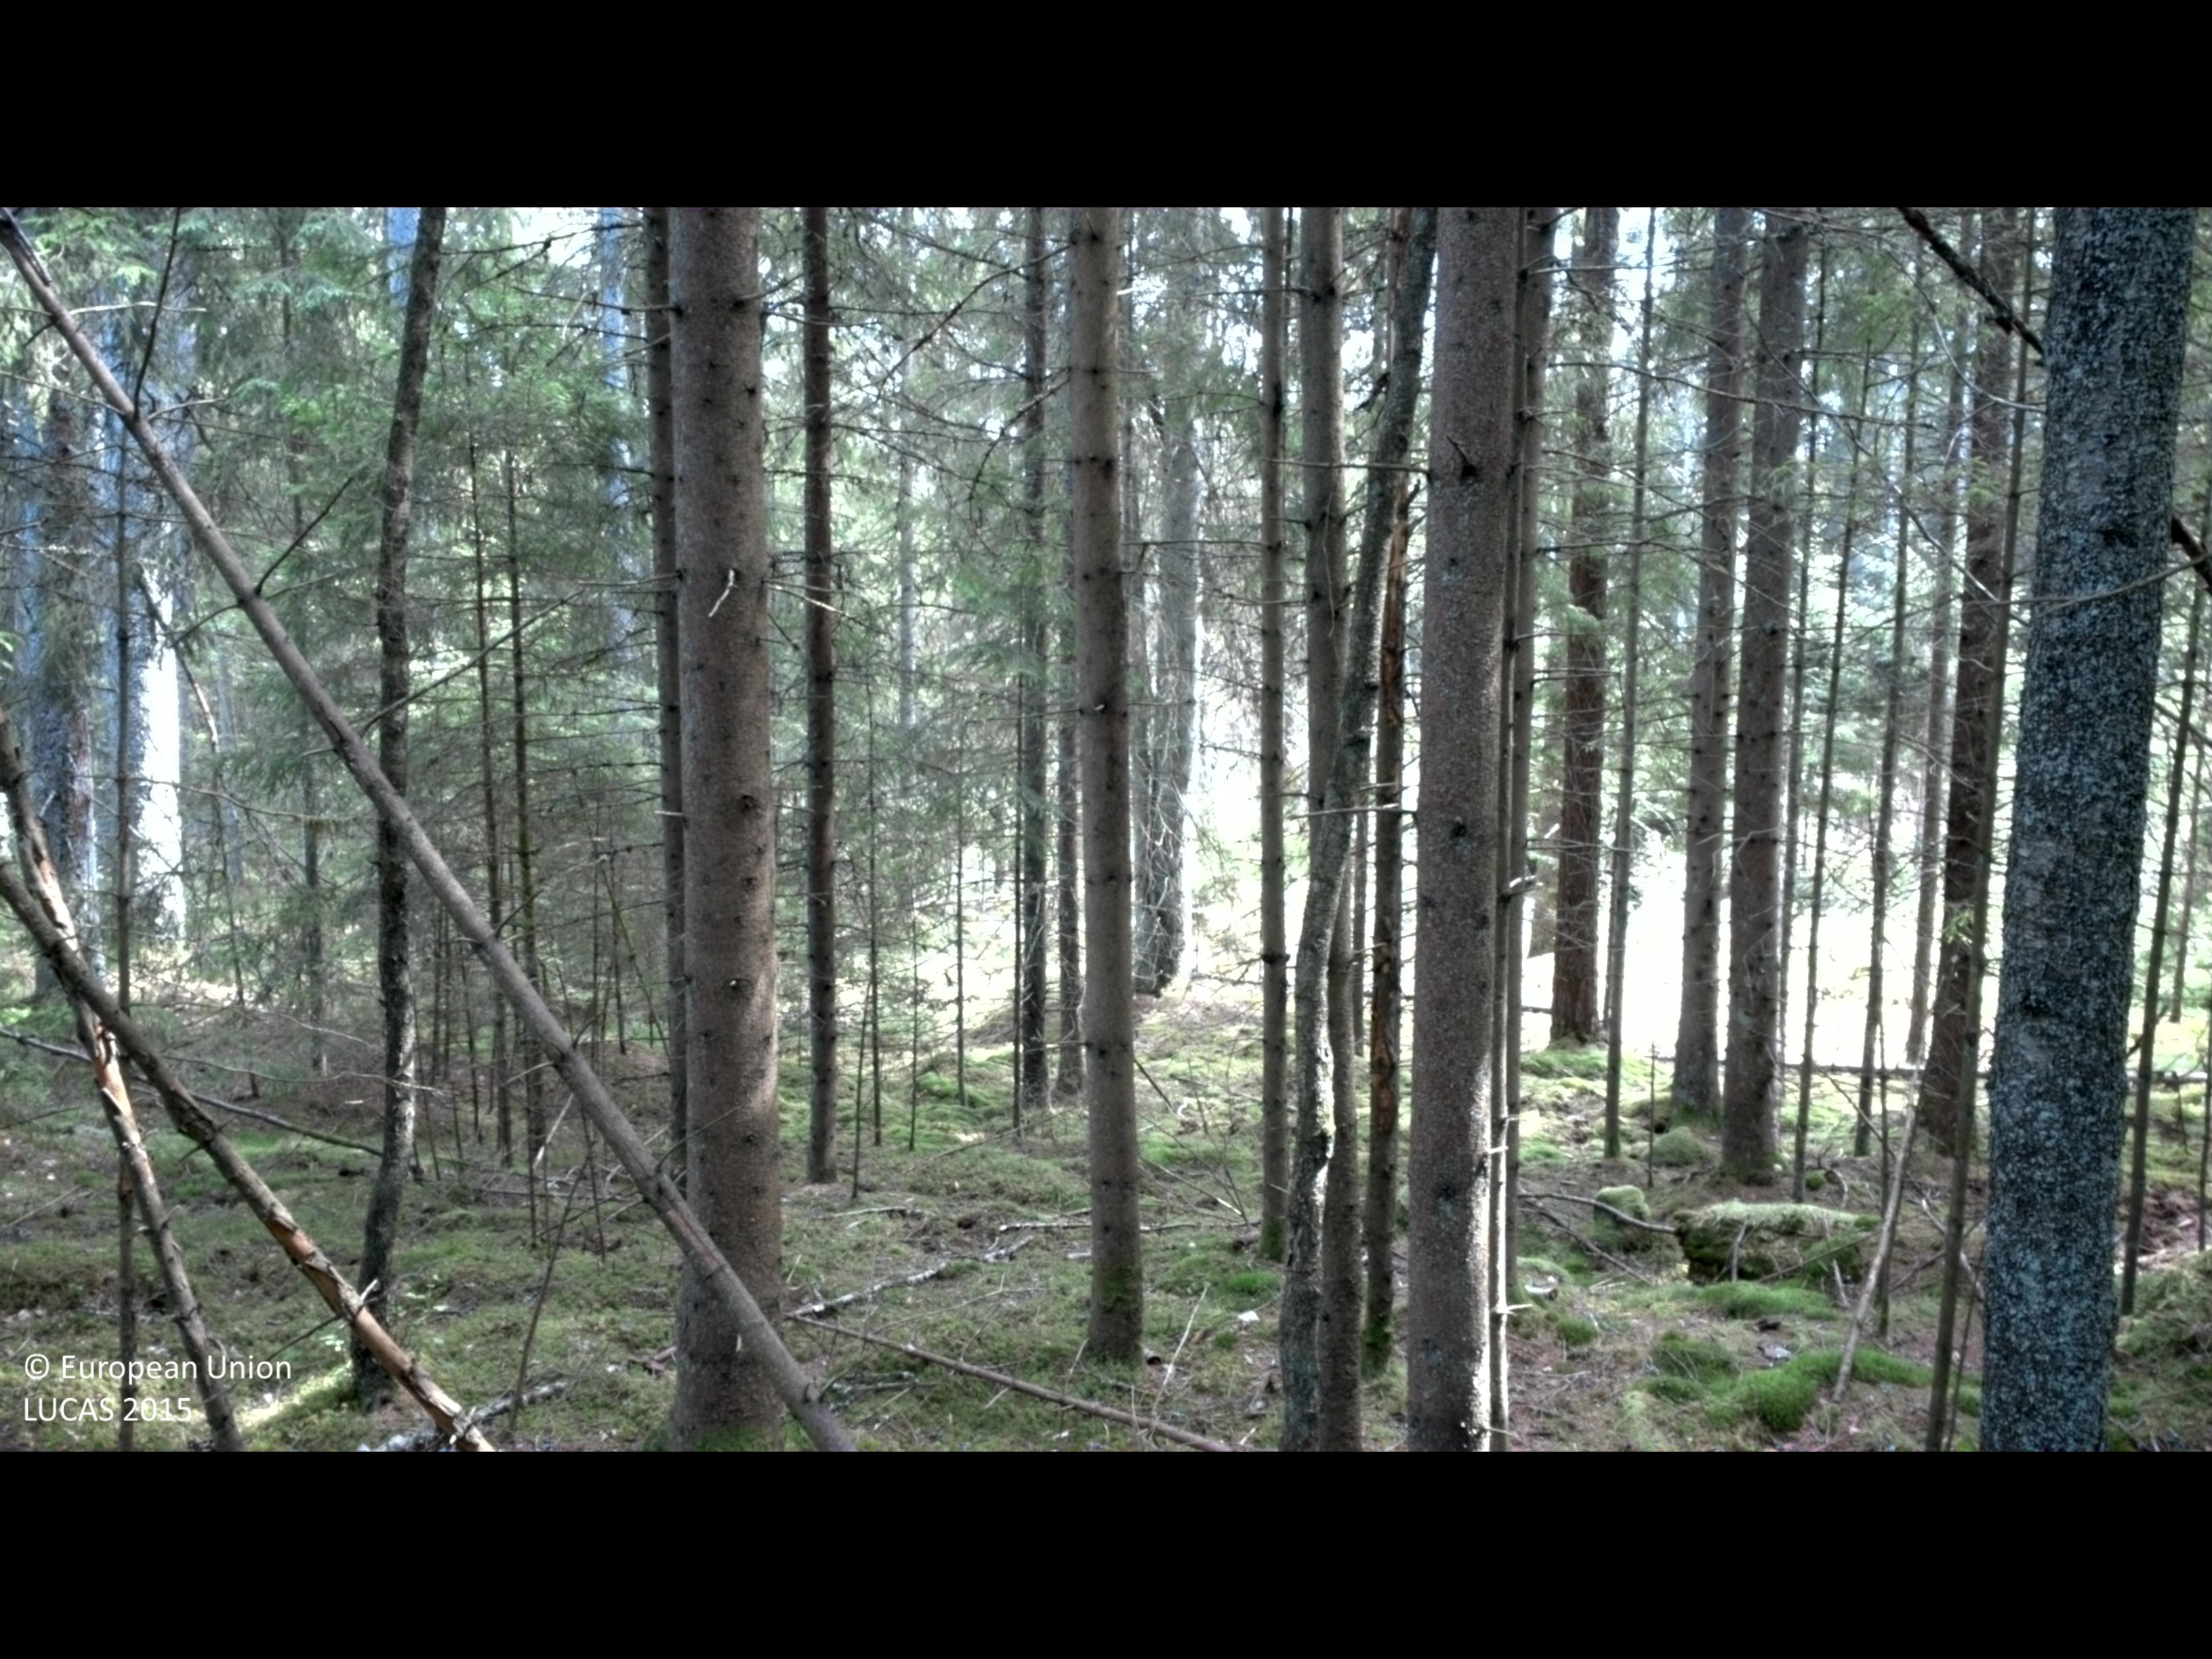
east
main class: Woodland
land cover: Spruce dominated coniferous woodland
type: boreal forest
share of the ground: > 75 %
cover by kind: coniferous forest trees 80 %, shrubs 10 %, herbaceous plants 5 %, lichens and mosses 5 %
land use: Forestry
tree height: > 5 m
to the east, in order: Spruce dominated coniferous woodland; Ditches and canals; Spruce dominated coniferous woodland; Pine dominated coniferous woodland; Ditches and canals; Pine dominated mixed woodland; Spruce dominated coniferous woodland; Tracks; Spruce dominated coniferous woodland
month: July
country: SE
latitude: 56.5270
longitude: 13.8174
